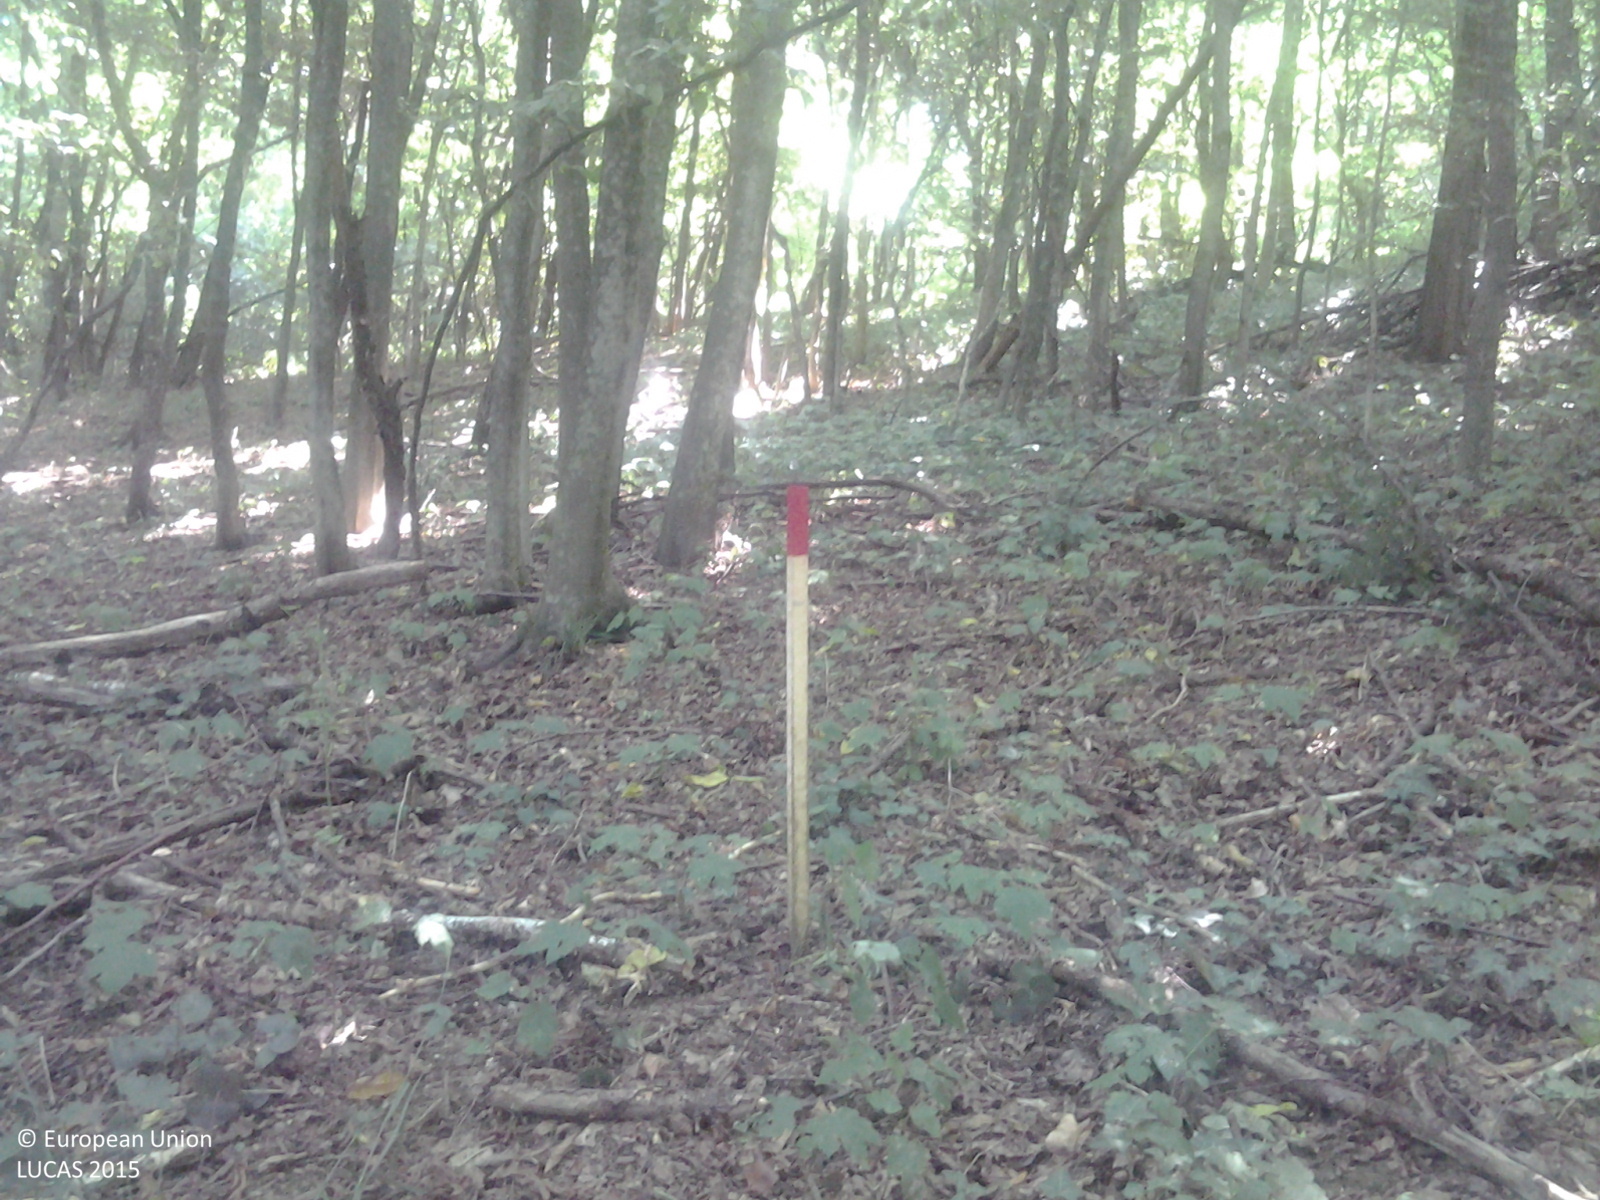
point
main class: Woodland
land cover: Broadleaved woodland
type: beech forest
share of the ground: > 75 %
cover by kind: broadleaved forest trees 100 %
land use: Forestry
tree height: > 5 m
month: August
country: HU
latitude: 46.5679
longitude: 17.0877
